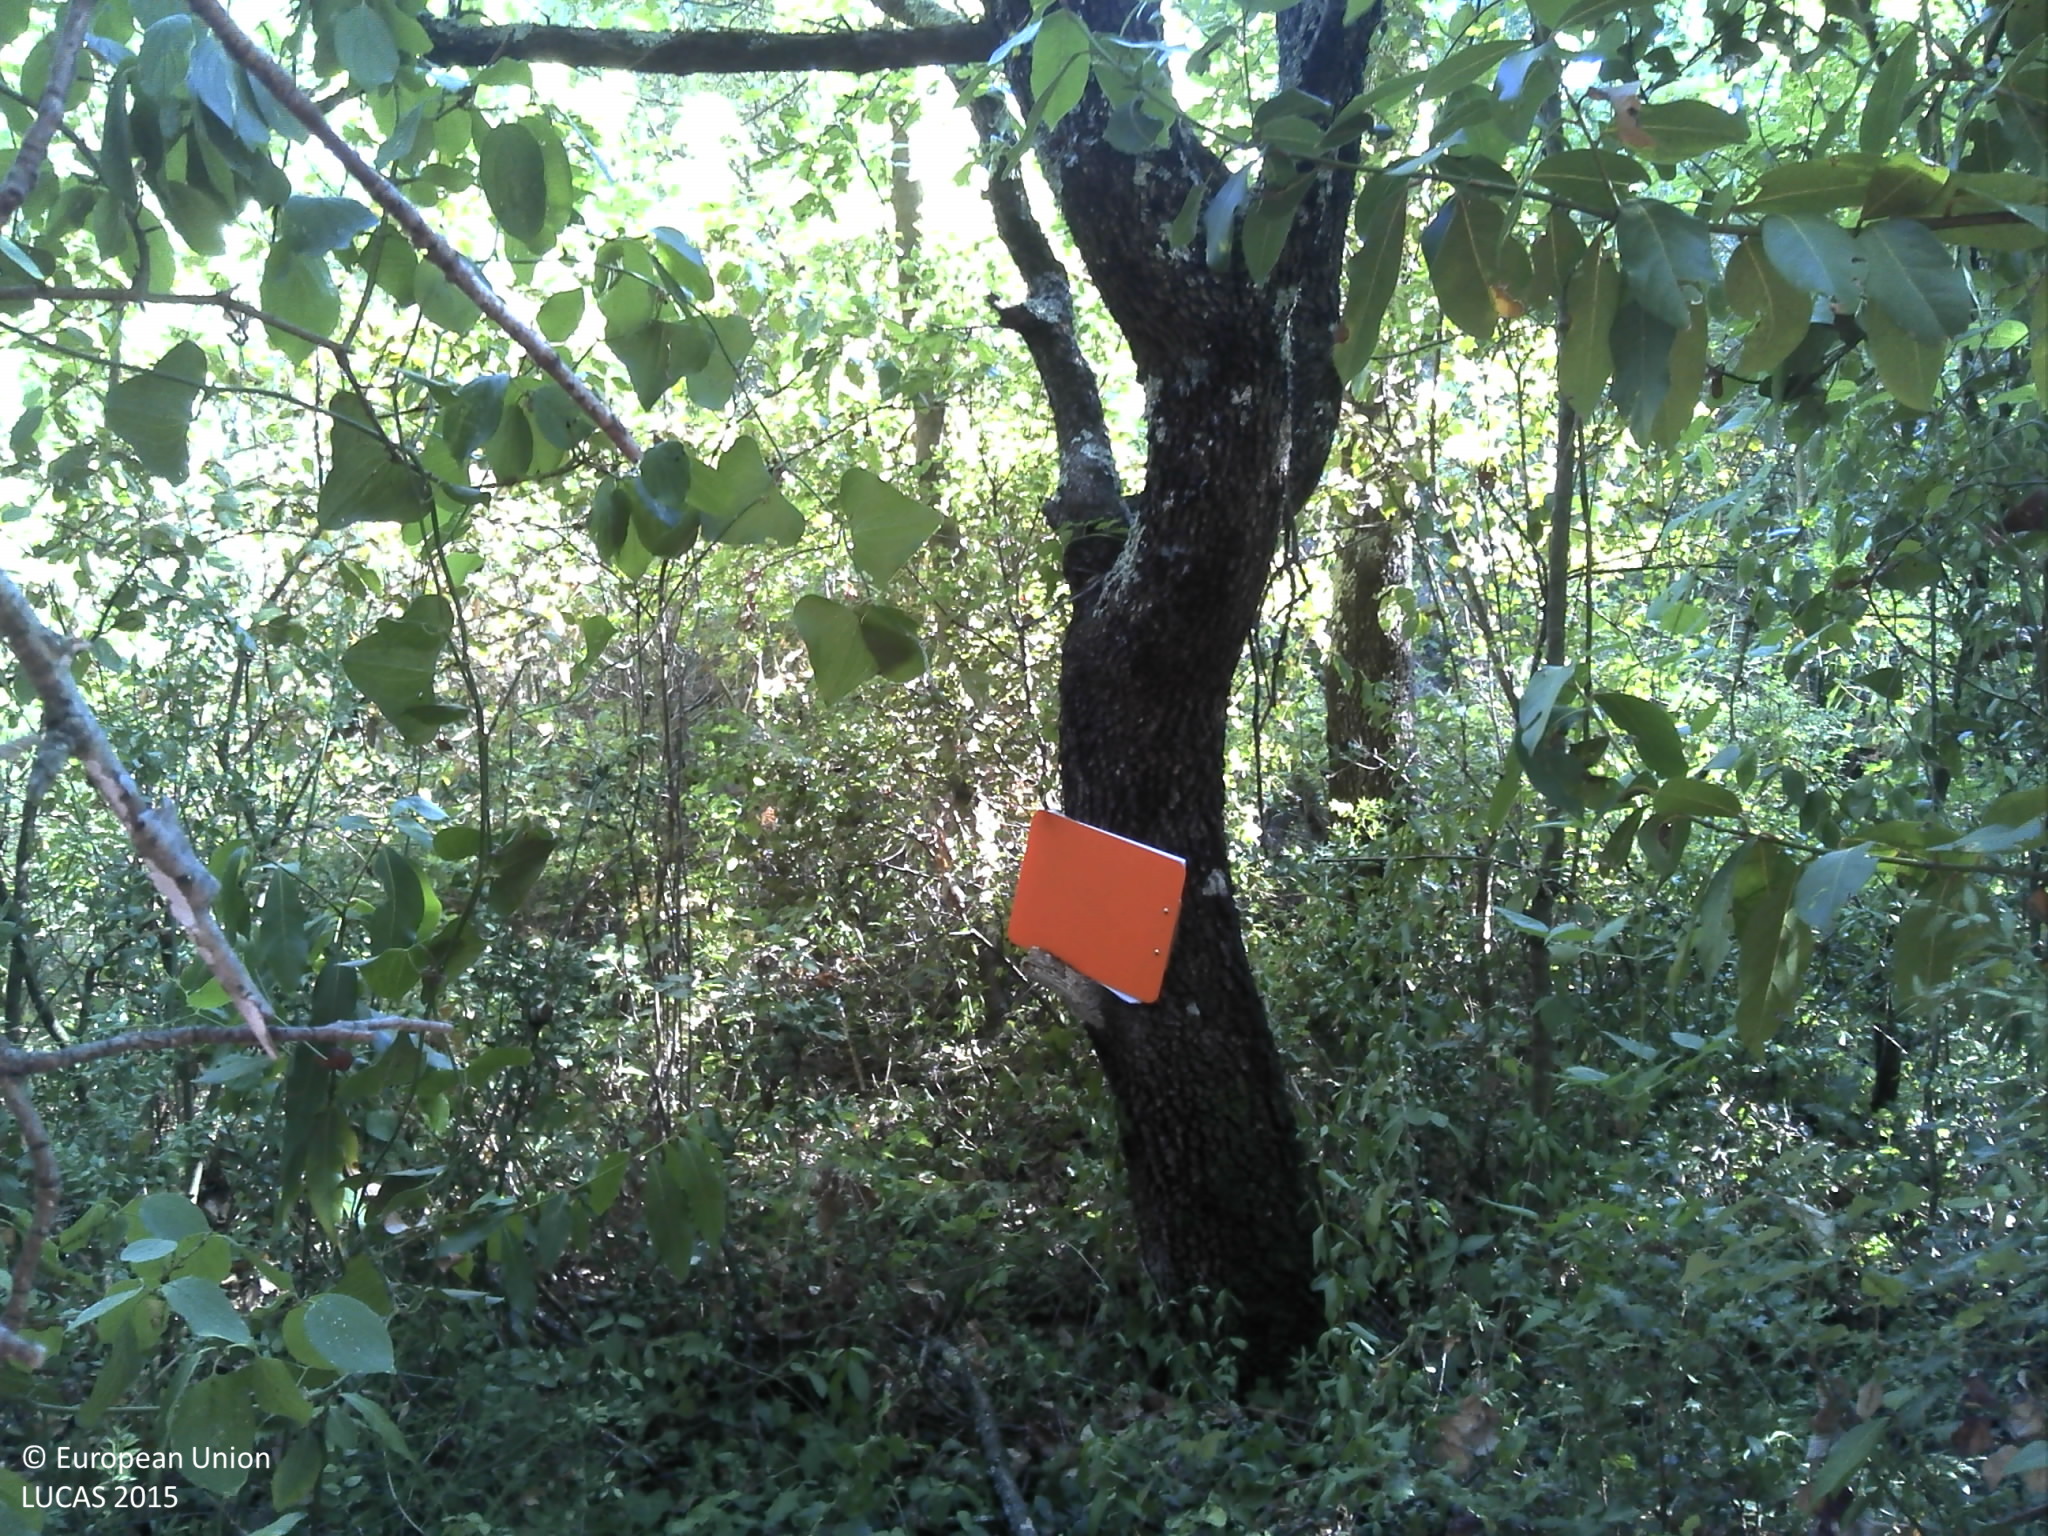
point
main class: Woodland
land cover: Broadleaved woodland
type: acidophilous oak and oak-birch forest
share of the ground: > 75 %
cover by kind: broadleaved forest trees 80 %, herbaceous plants 10 %, unconsolidated bare surface 10 %
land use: Semi-natural and natural areas not in use
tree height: > 5 m
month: July
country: FR
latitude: 43.6356
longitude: 3.1534
